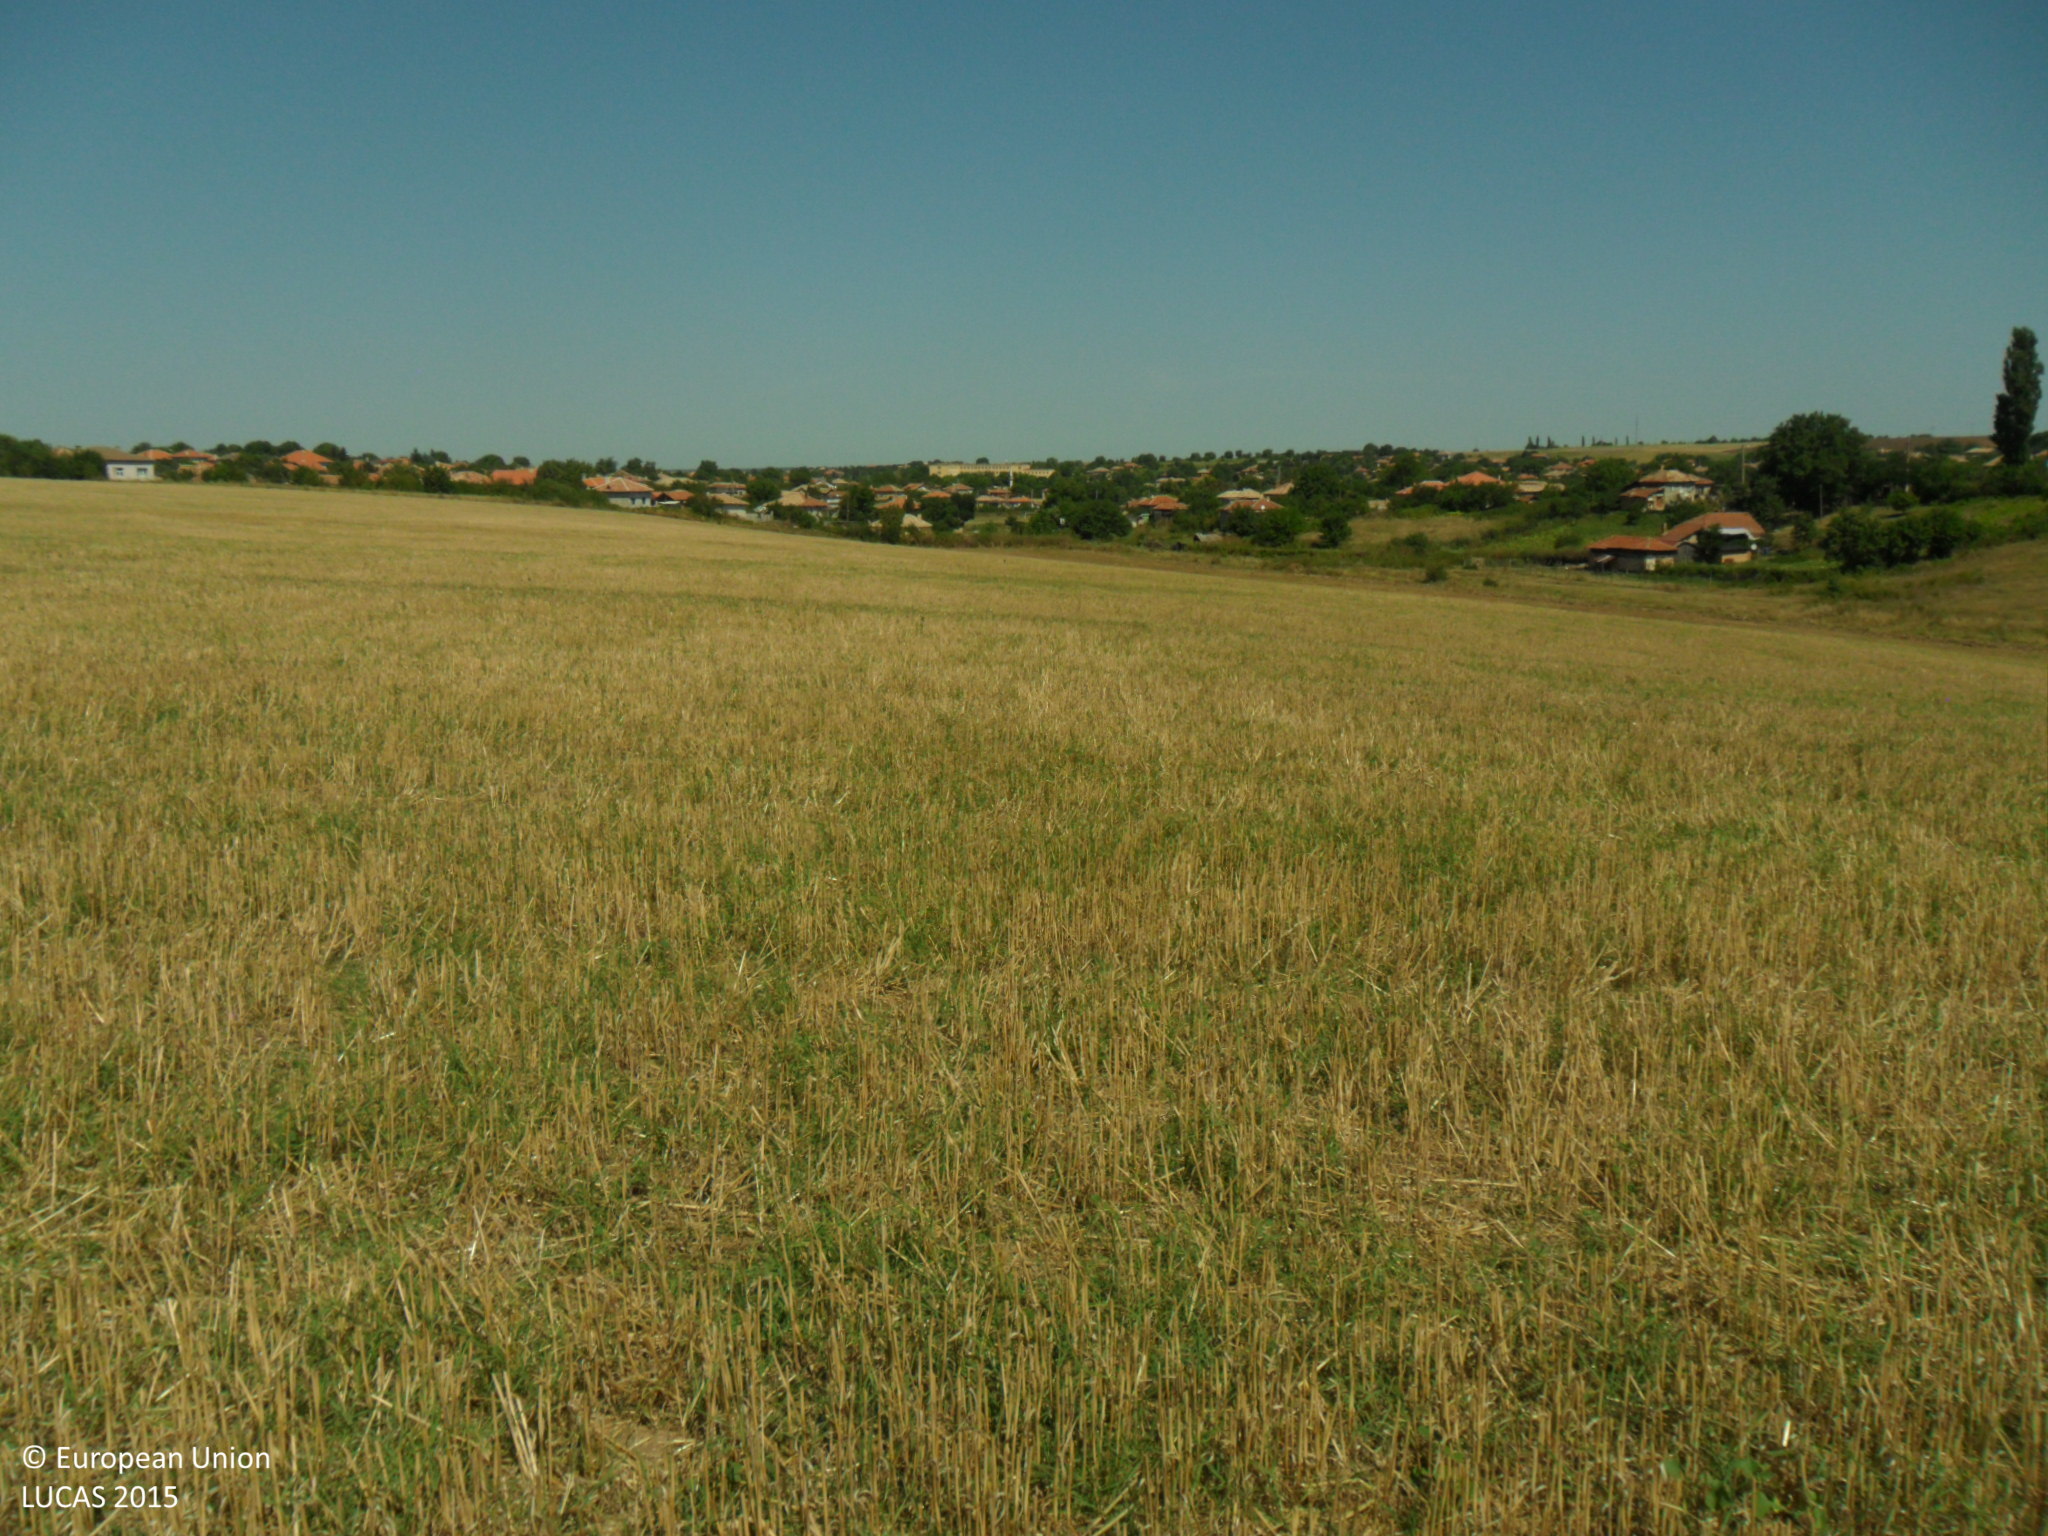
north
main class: Cropland
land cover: Common wheat
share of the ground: 50 - 75 %
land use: Agriculture (excluding fallow land and kitchen gardens)
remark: Harvested field
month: August
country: BG
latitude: 43.5937
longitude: 26.4677
